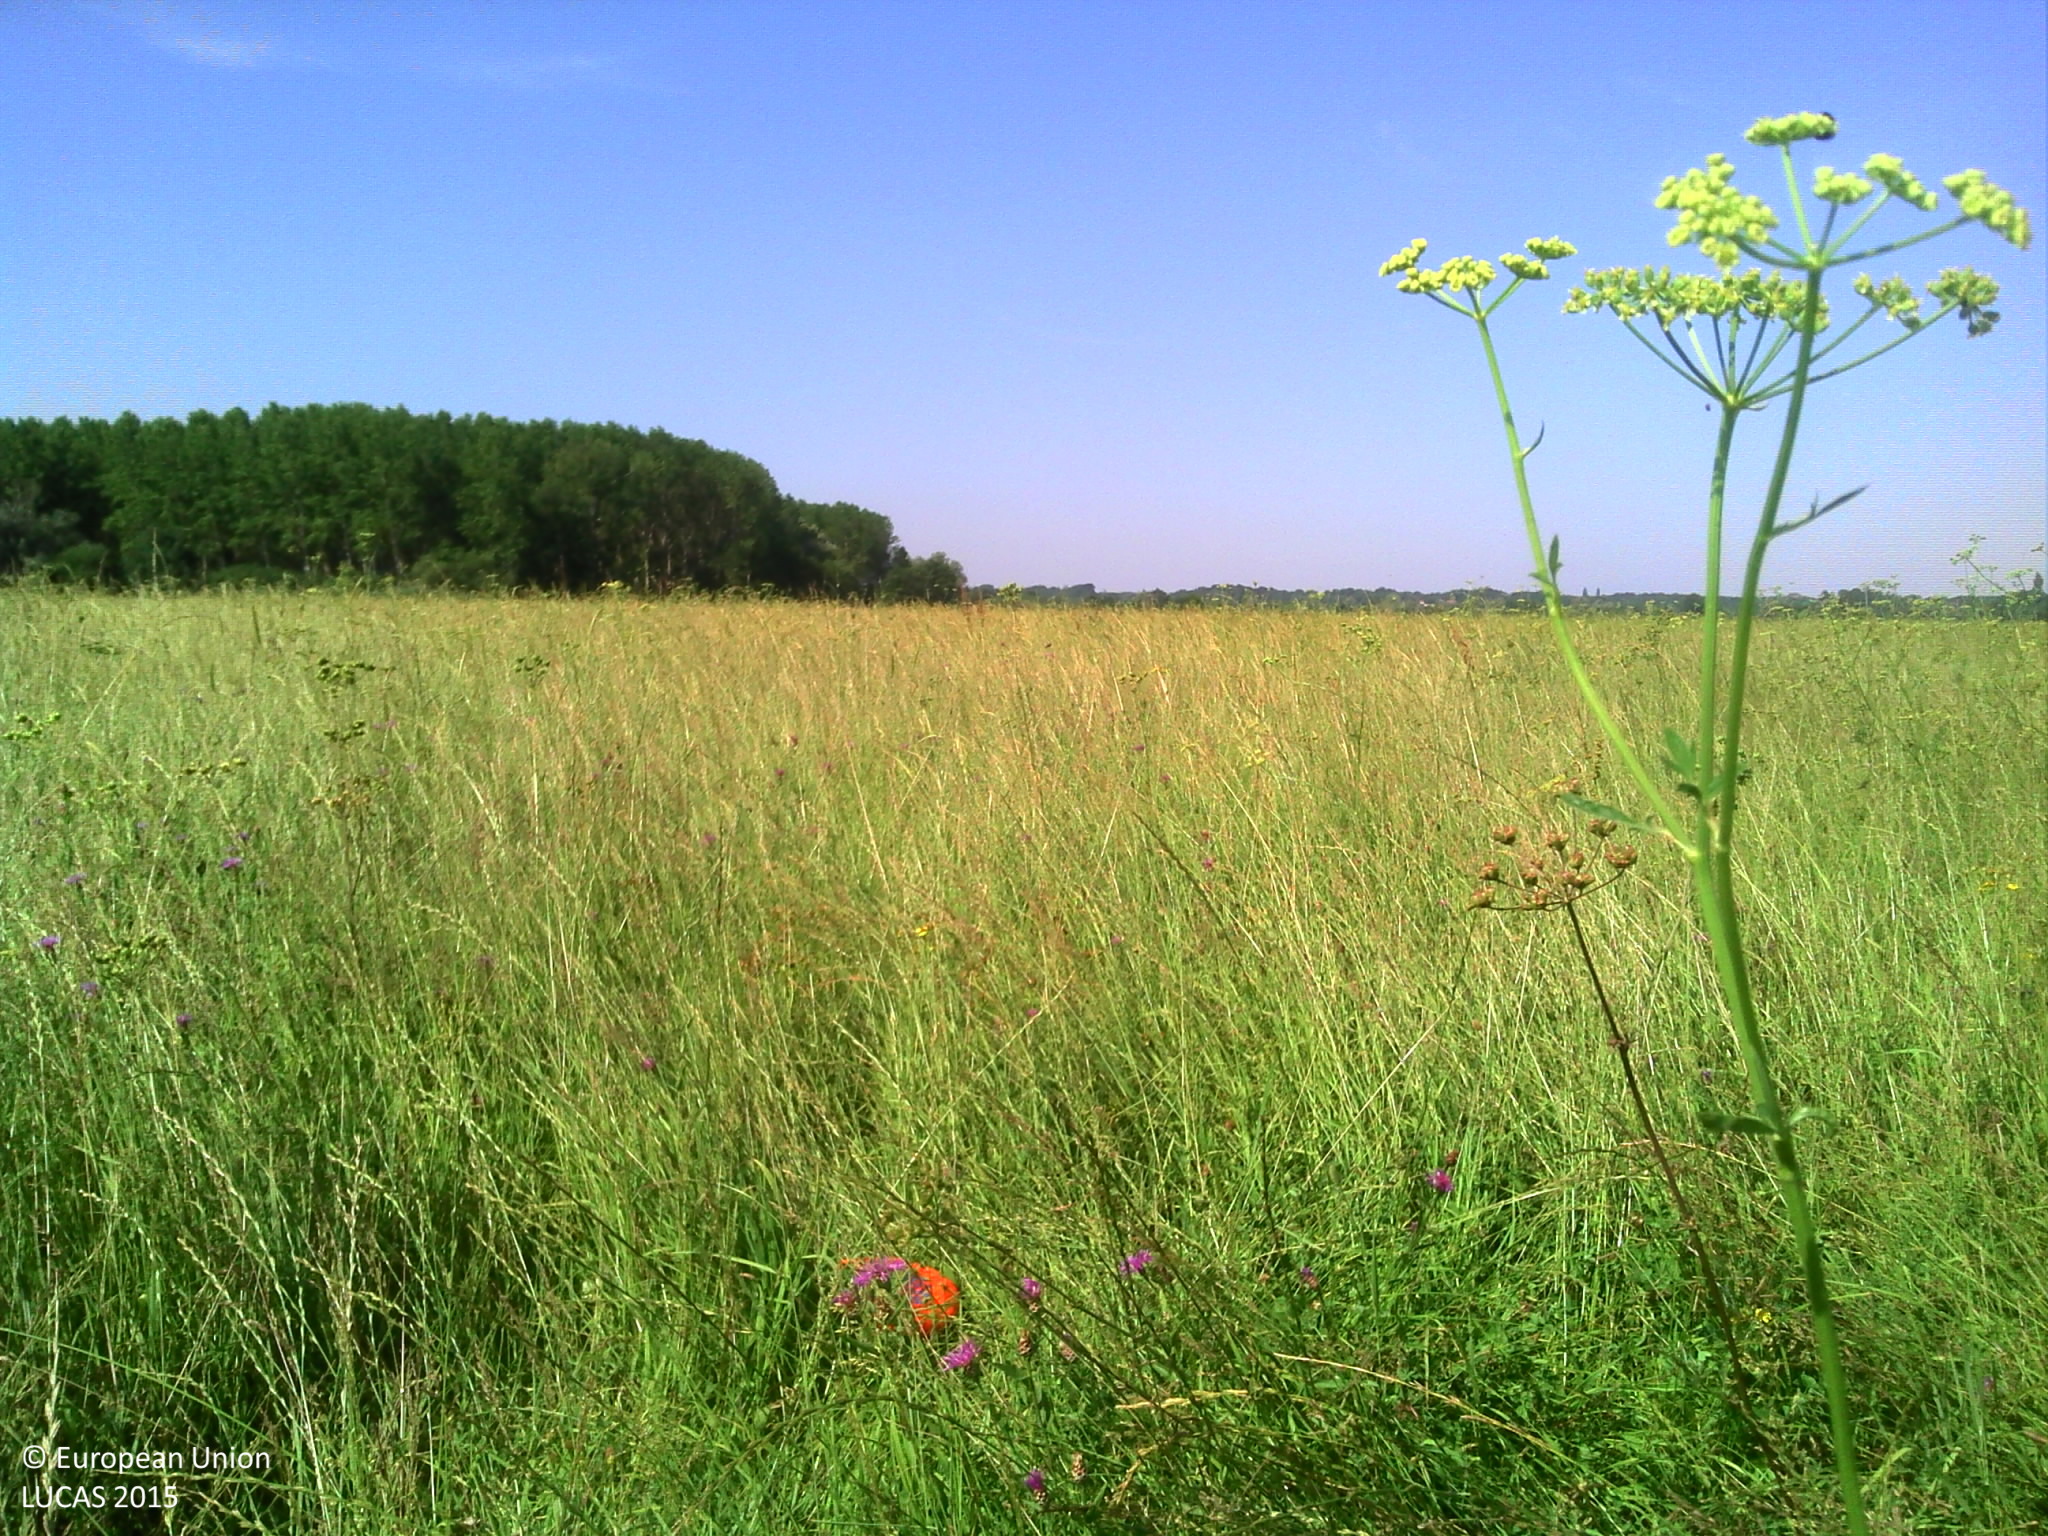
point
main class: Grassland
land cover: Grassland without tree/shrub cover
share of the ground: > 75 %
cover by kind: herbaceous plants 100 %
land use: Agriculture (excluding fallow land and kitchen gardens)
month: June
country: FR
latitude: 46.7352
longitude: 5.3039
